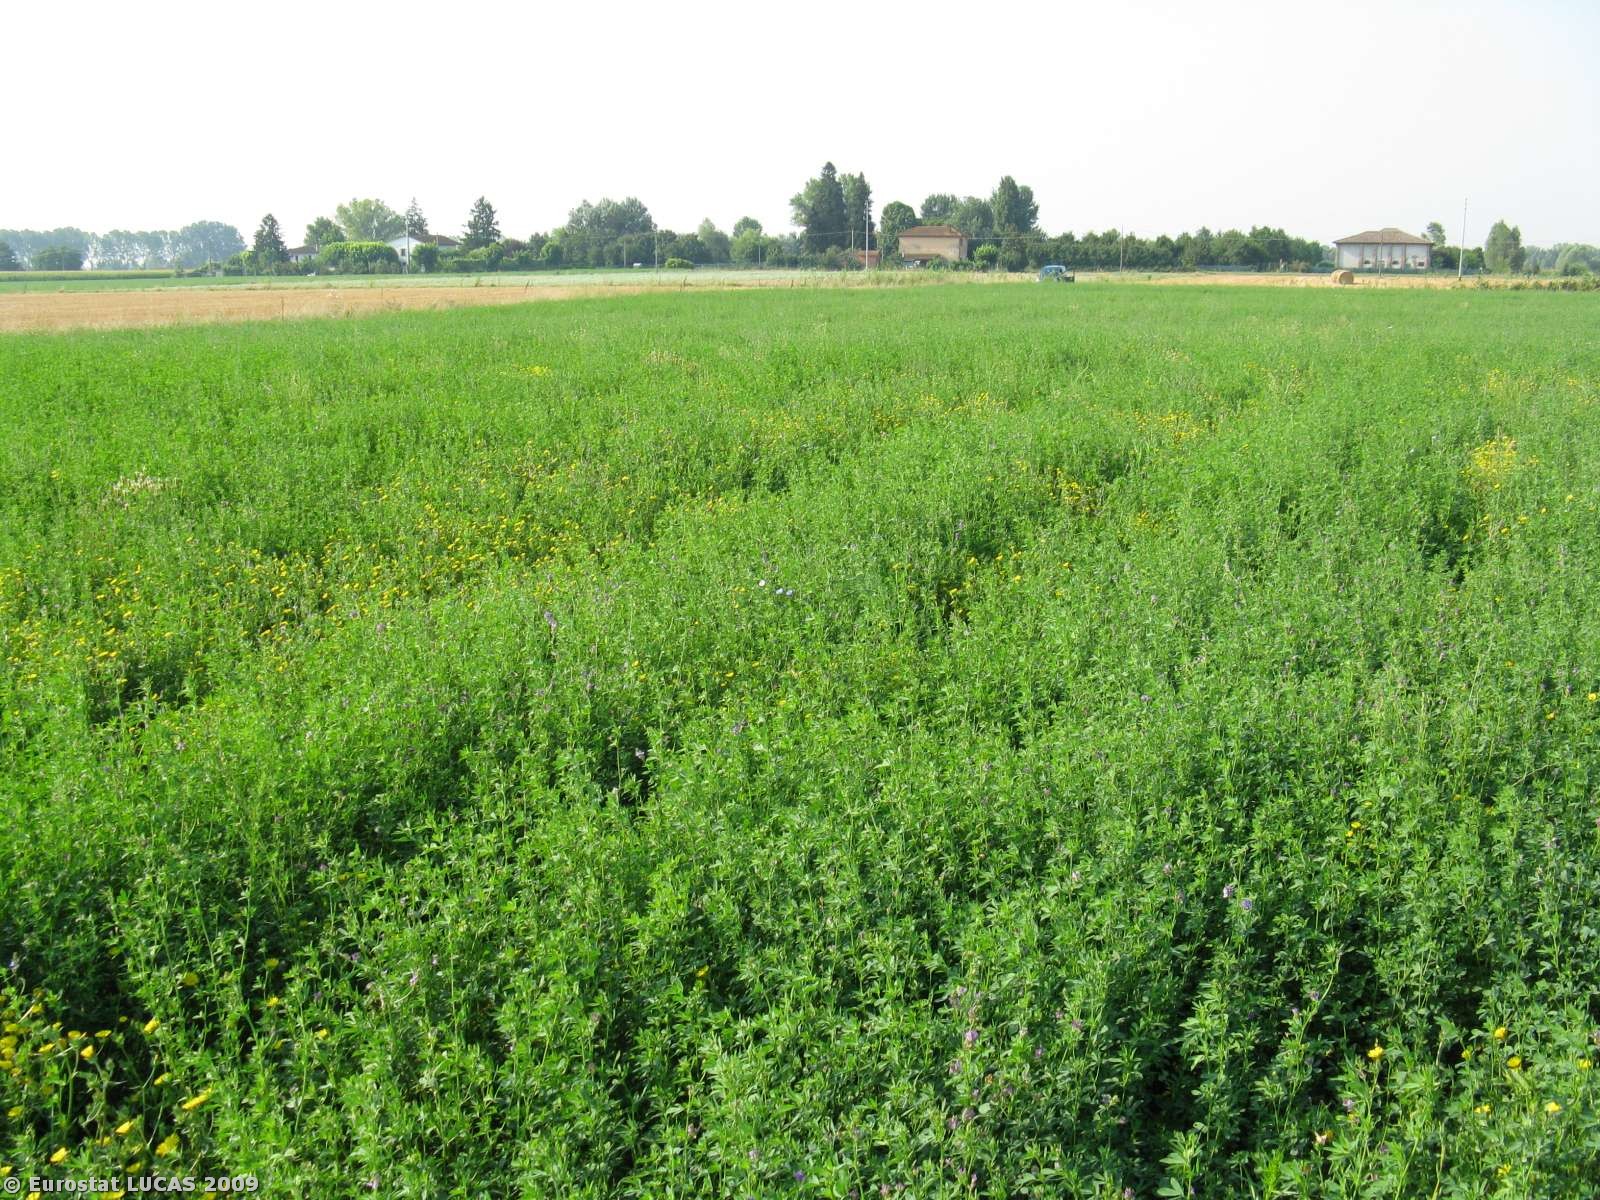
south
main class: Cropland
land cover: Lucerne
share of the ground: > 75 %
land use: Agriculture (excluding fallow land and kitchen gardens)
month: July
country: IT
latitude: 44.5900
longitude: 11.6467
